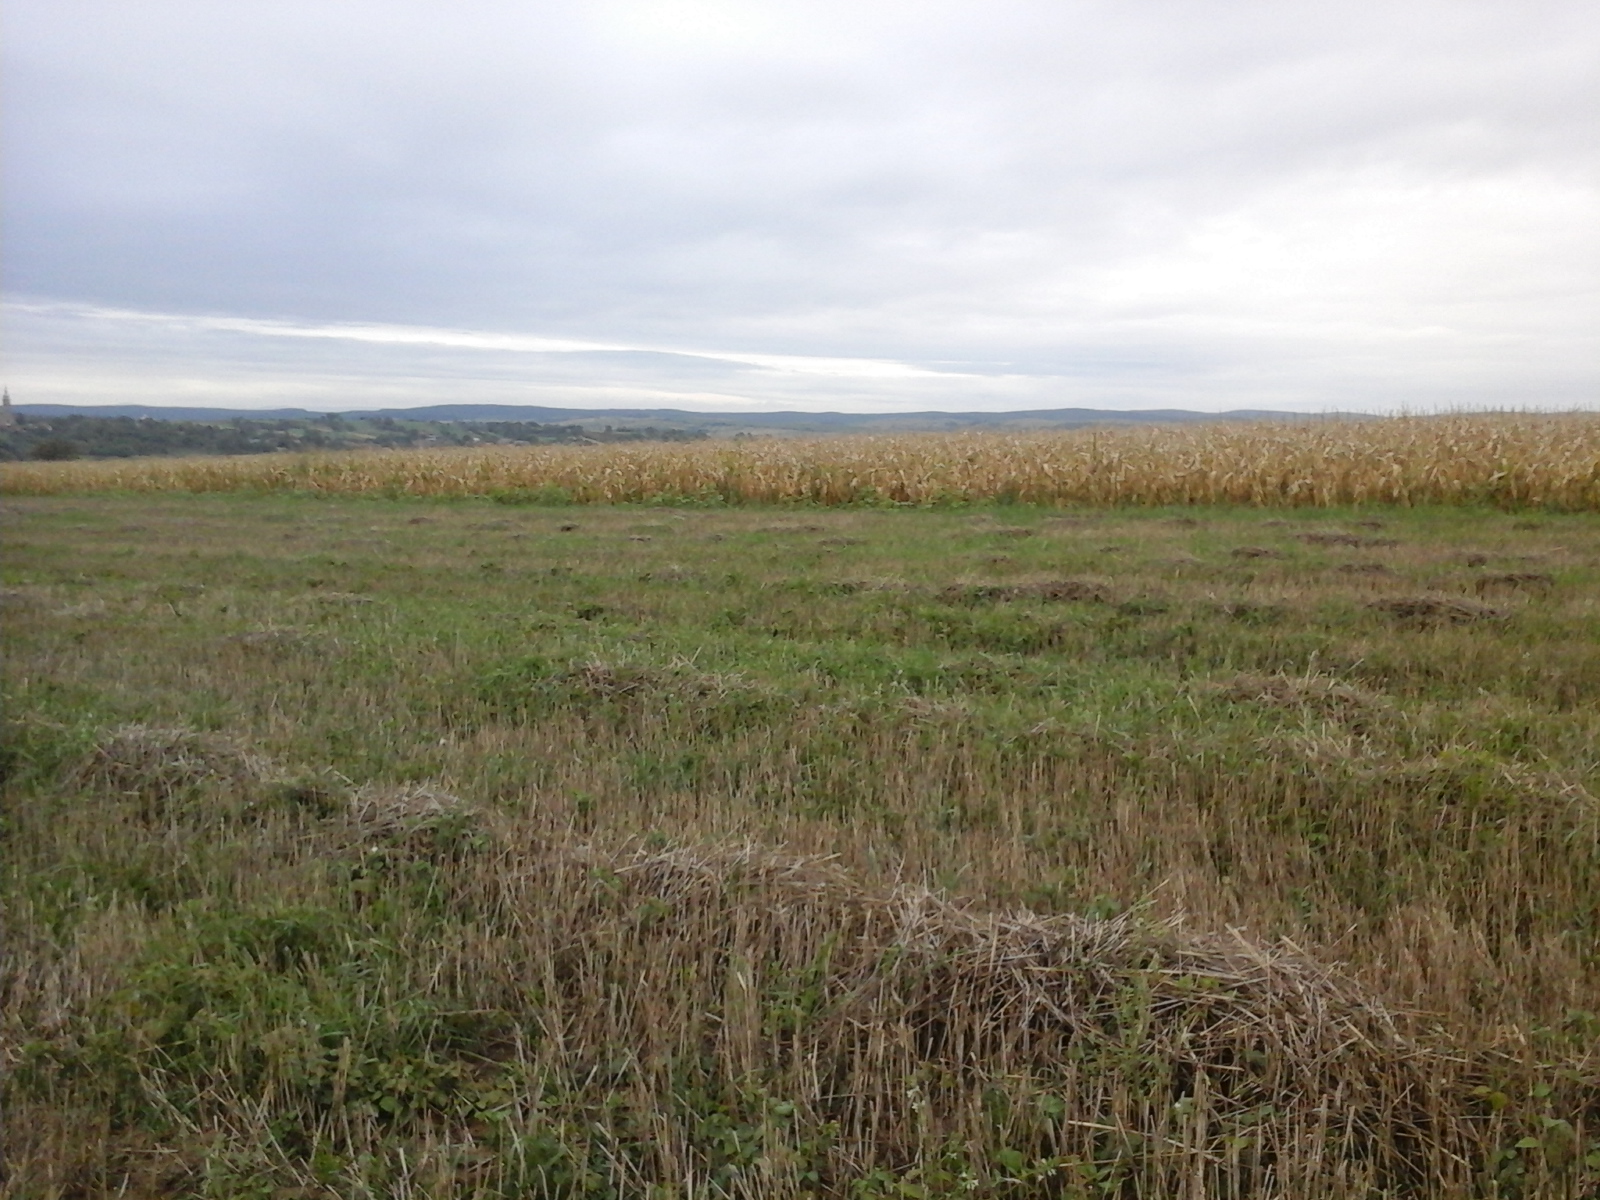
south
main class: Cropland
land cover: Common wheat
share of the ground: > 75 %
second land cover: Spontaneously vegetated surfaces
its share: 50 - 75 %
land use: Agriculture (excluding fallow land and kitchen gardens)
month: September
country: RO
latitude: 47.1489
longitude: 21.9825
